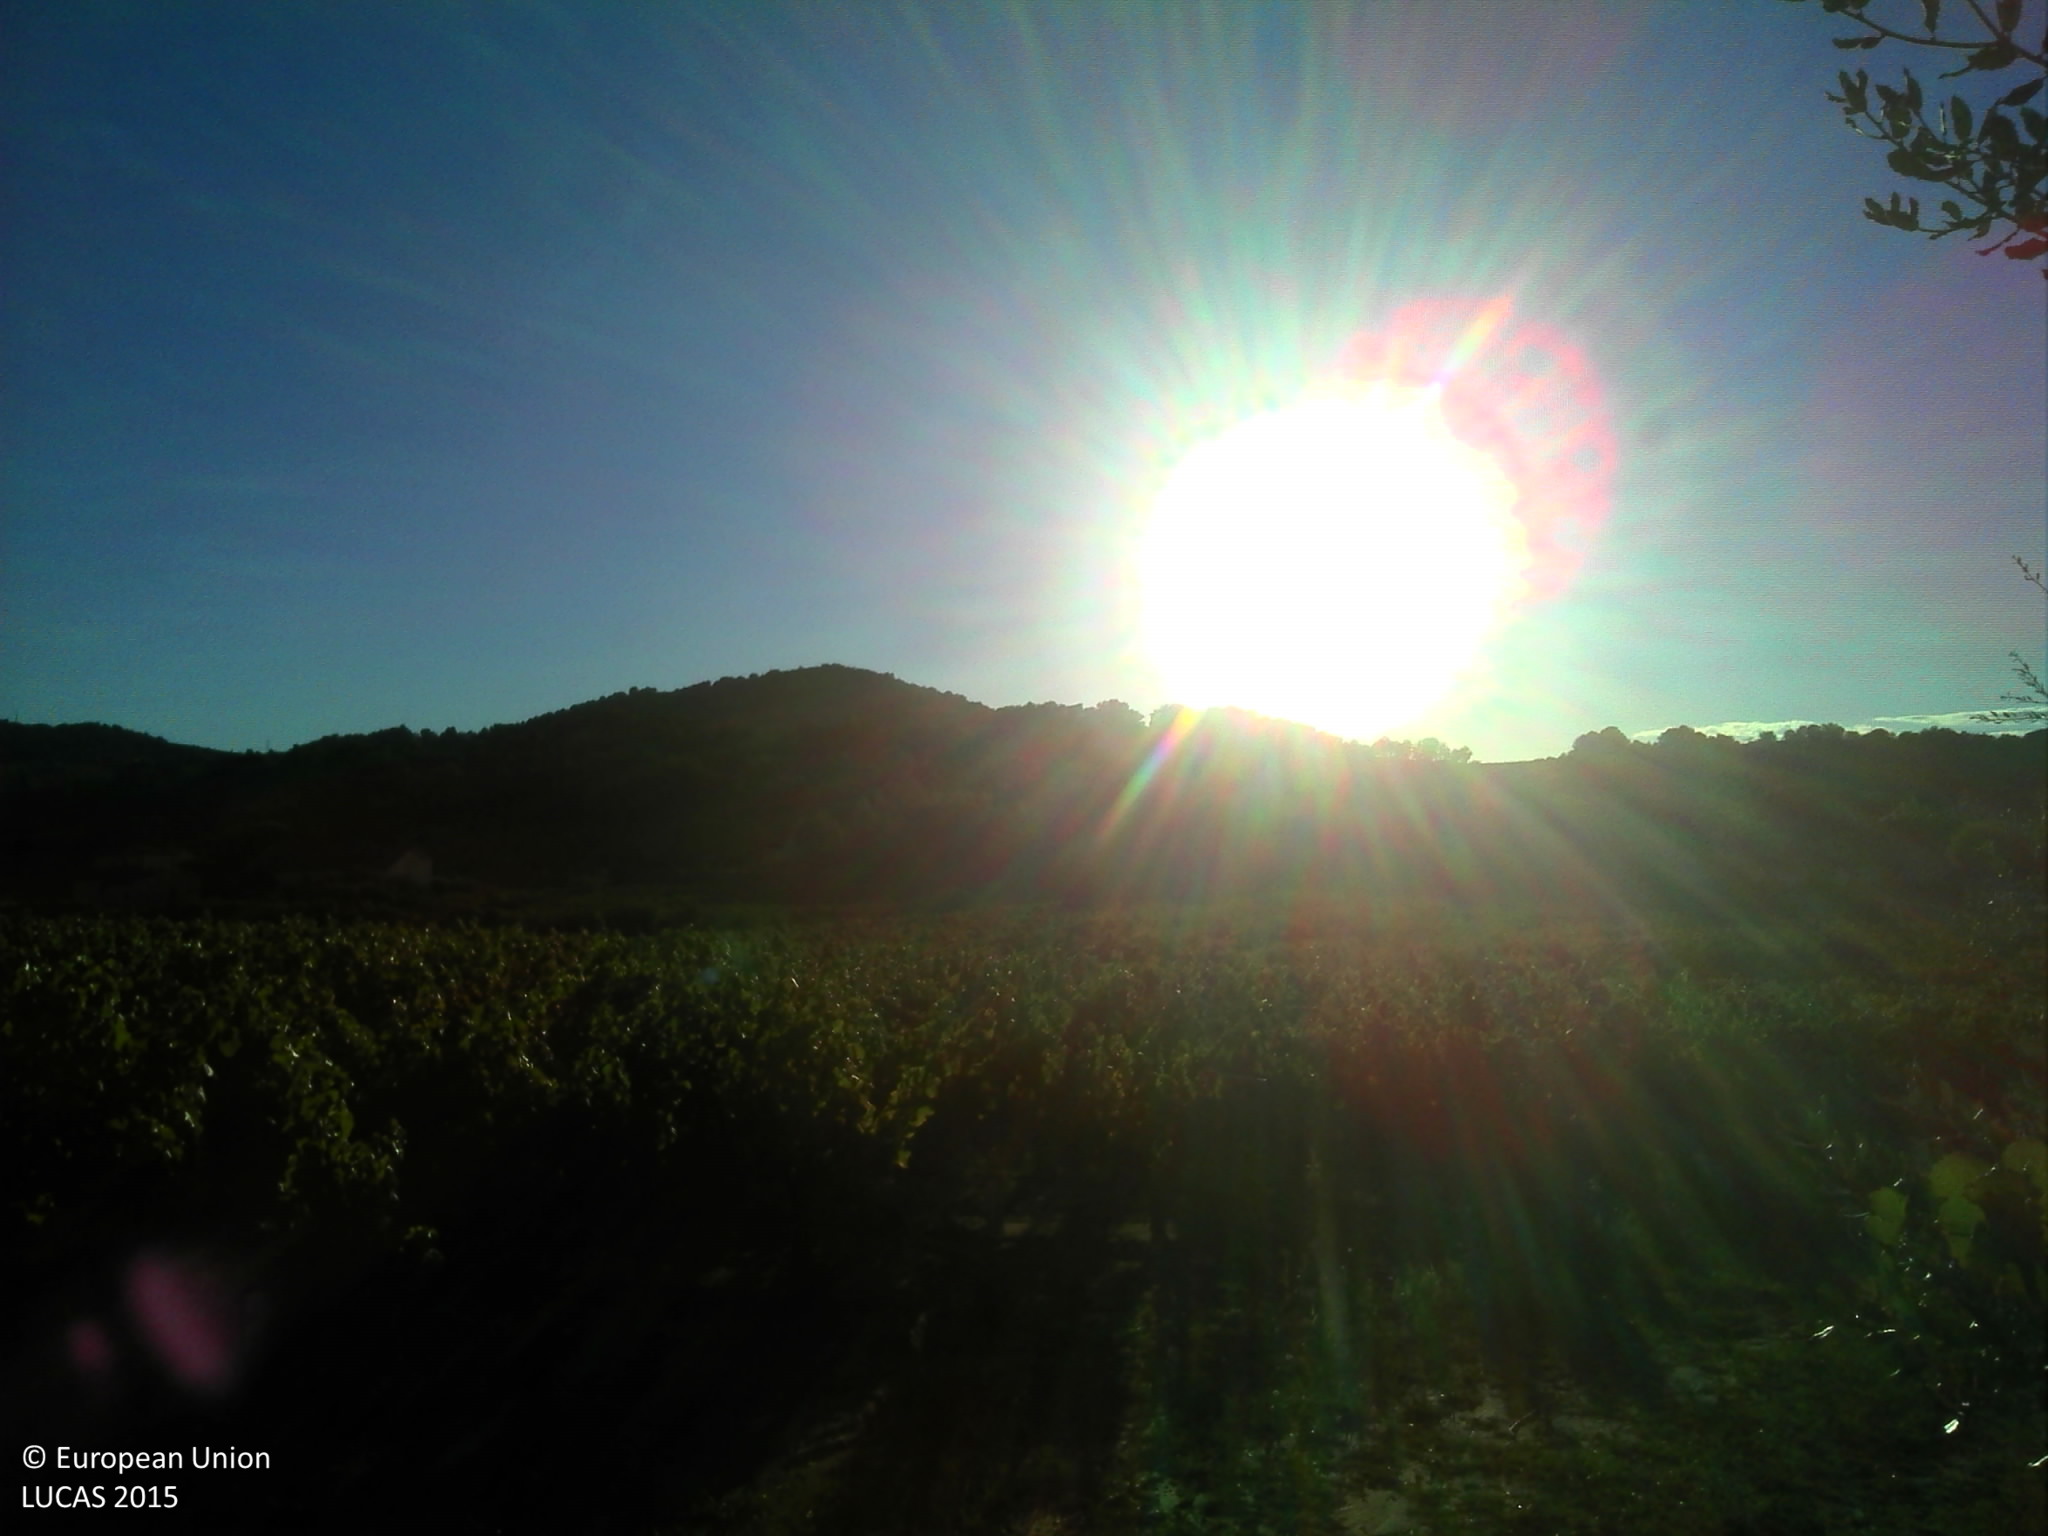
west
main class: Cropland
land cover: Vineyards
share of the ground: 10 - 25 %
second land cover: Other bare soil
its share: > 75 %
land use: Agriculture (excluding fallow land and kitchen gardens)
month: September
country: FR
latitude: 44.2894
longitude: 5.1076
